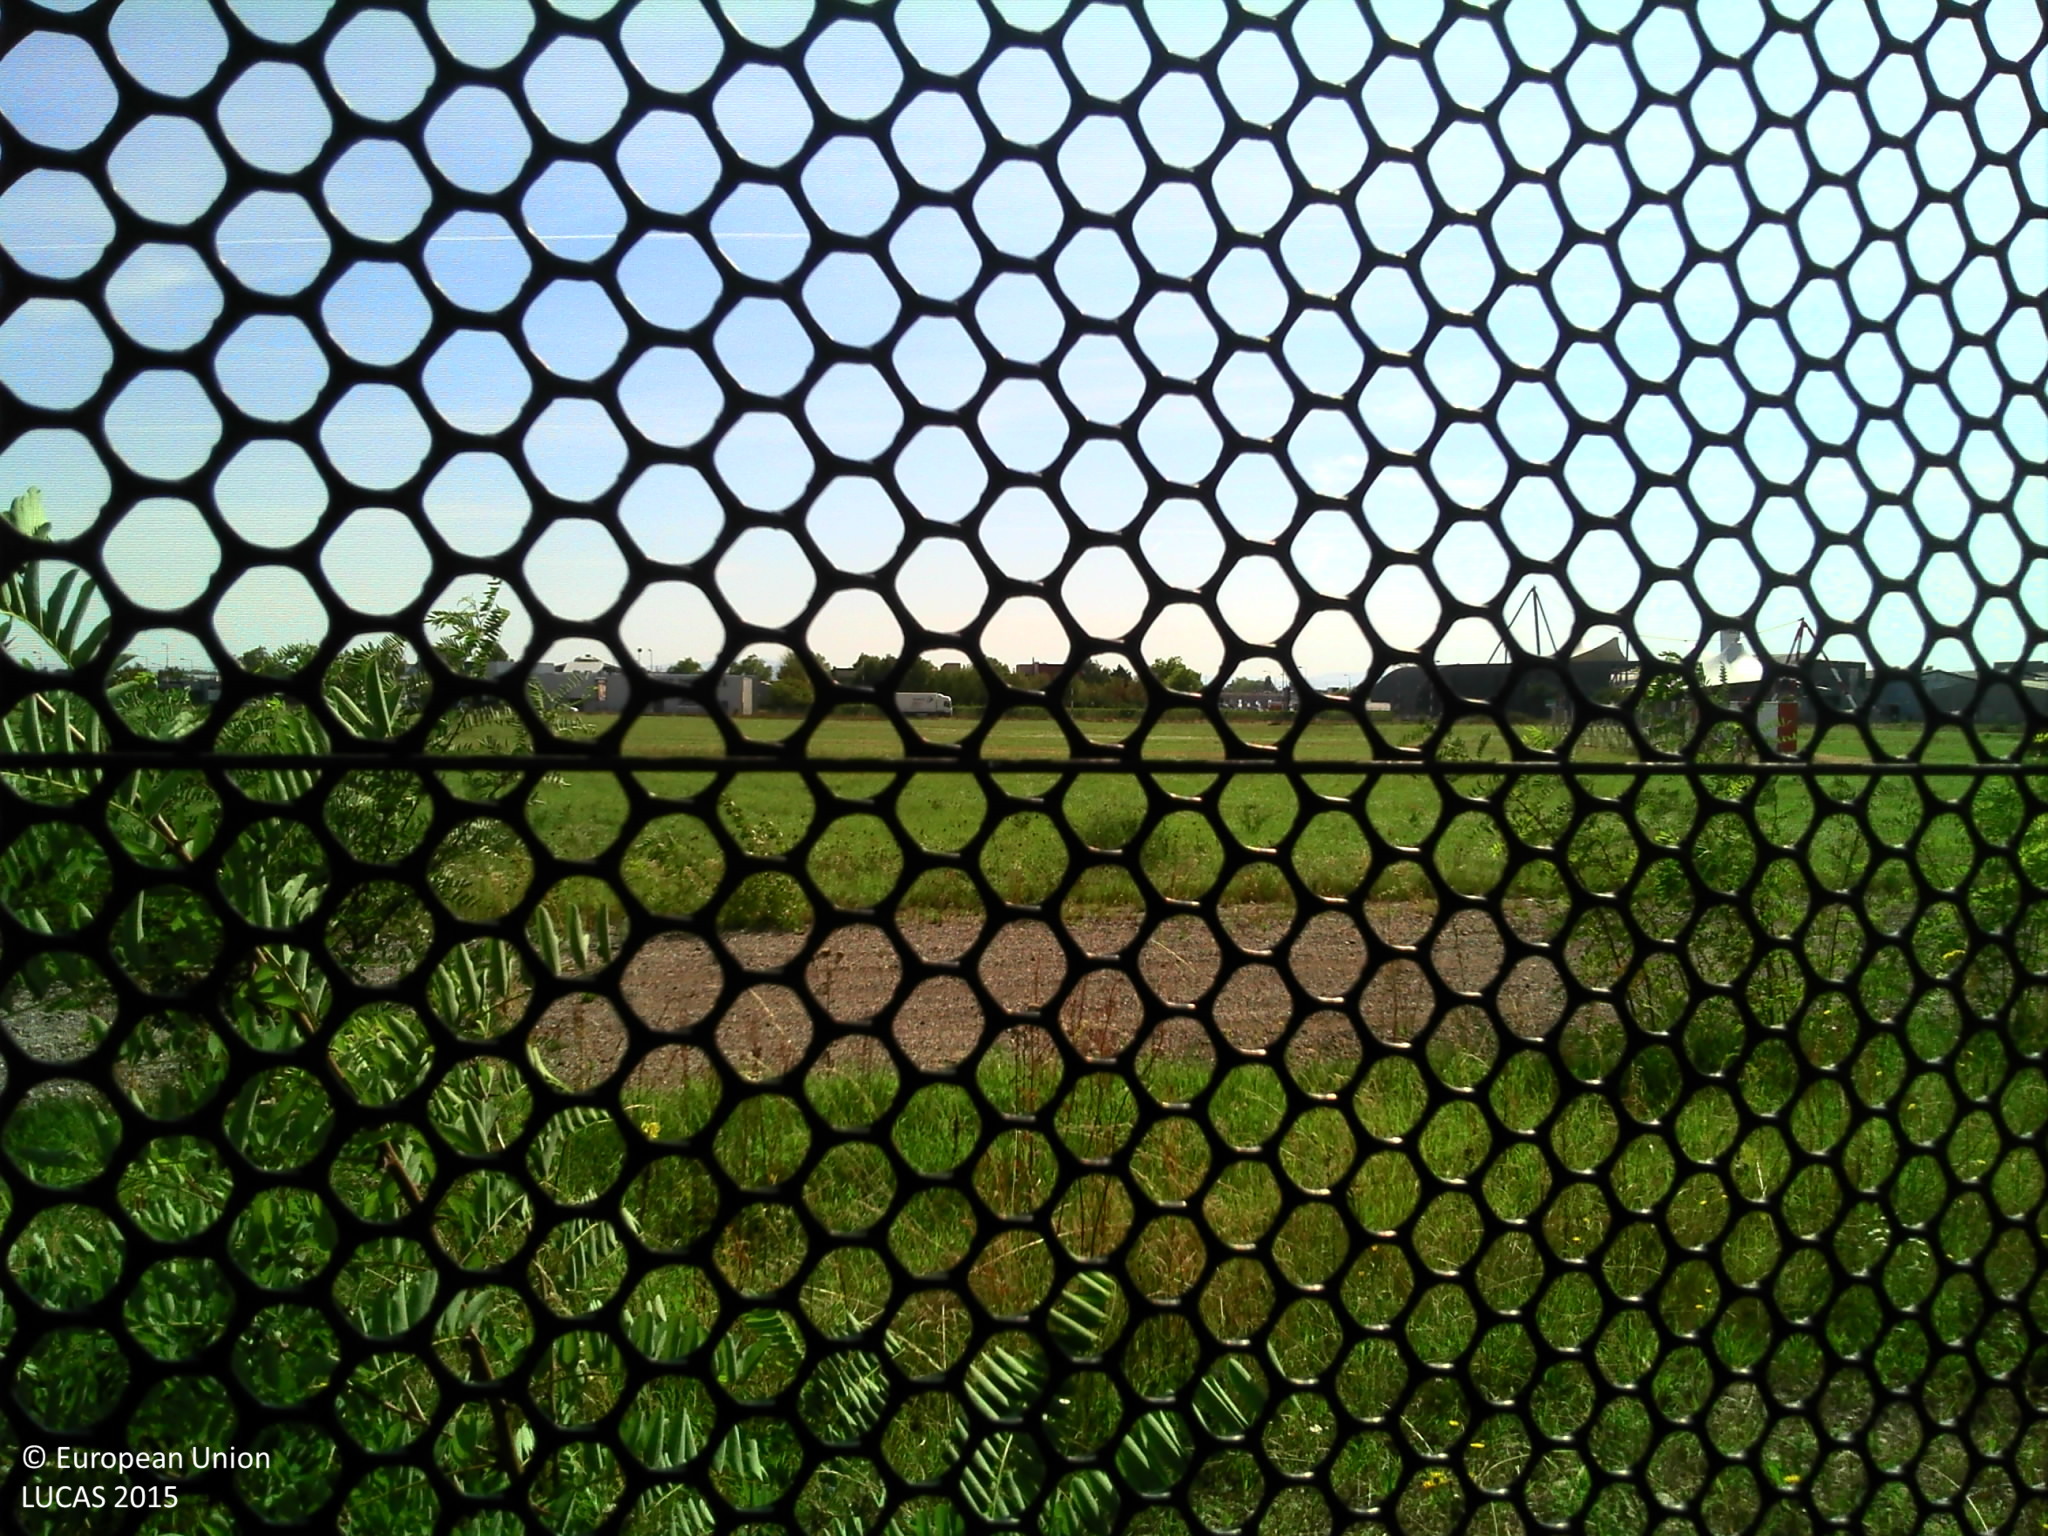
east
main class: Grassland
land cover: Grassland without tree/shrub cover
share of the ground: > 75 %
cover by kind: herbaceous plants 100 %
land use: Air transport
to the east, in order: Grassland without tree/shrub cover; Tracks; Grassland without tree/shrub cover
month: August
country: FR
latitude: 48.1018
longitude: 7.3556
